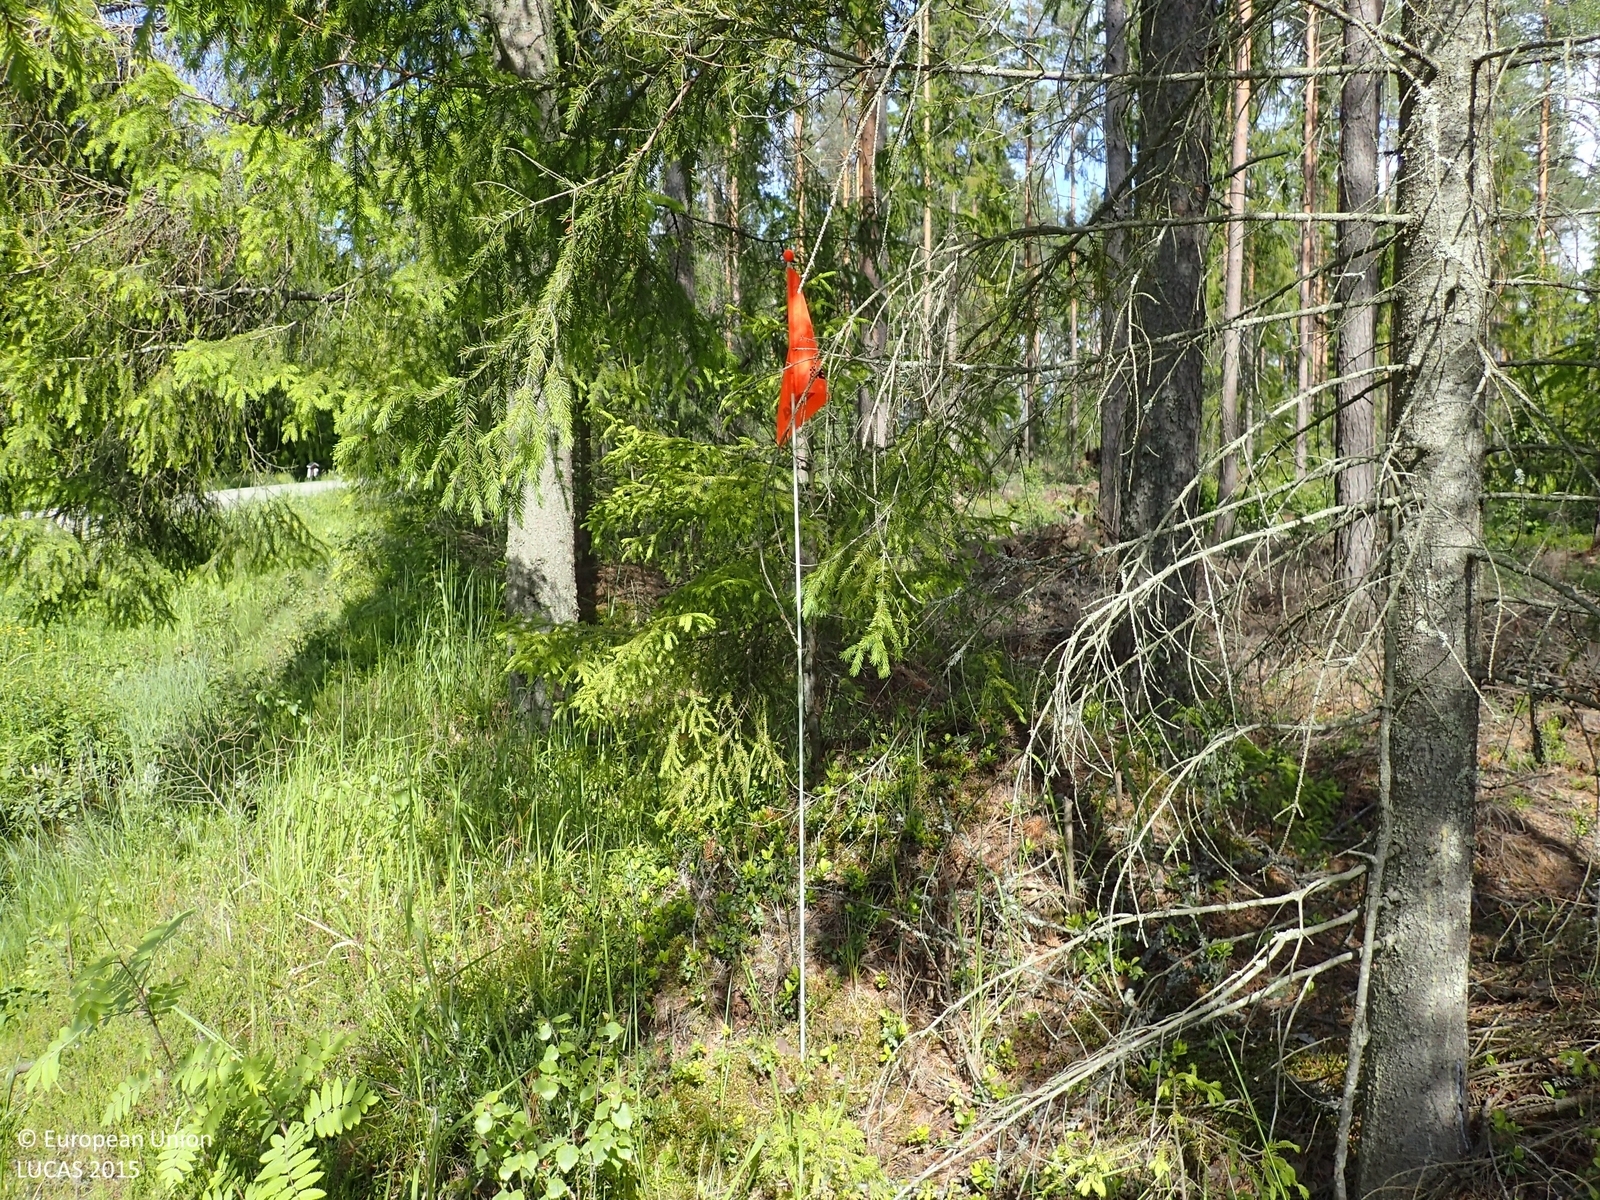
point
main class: Woodland
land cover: Pine dominated coniferous woodland
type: boreal forest
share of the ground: 25 - 50 %
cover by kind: coniferous forest trees 35 %, shrubs 30 %, herbaceous plants 20 %, lichens and mosses 10 %, broadleaved forest trees 5 %
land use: Forestry
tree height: > 5 m
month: June
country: FI
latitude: 62.4534
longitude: 21.6162
